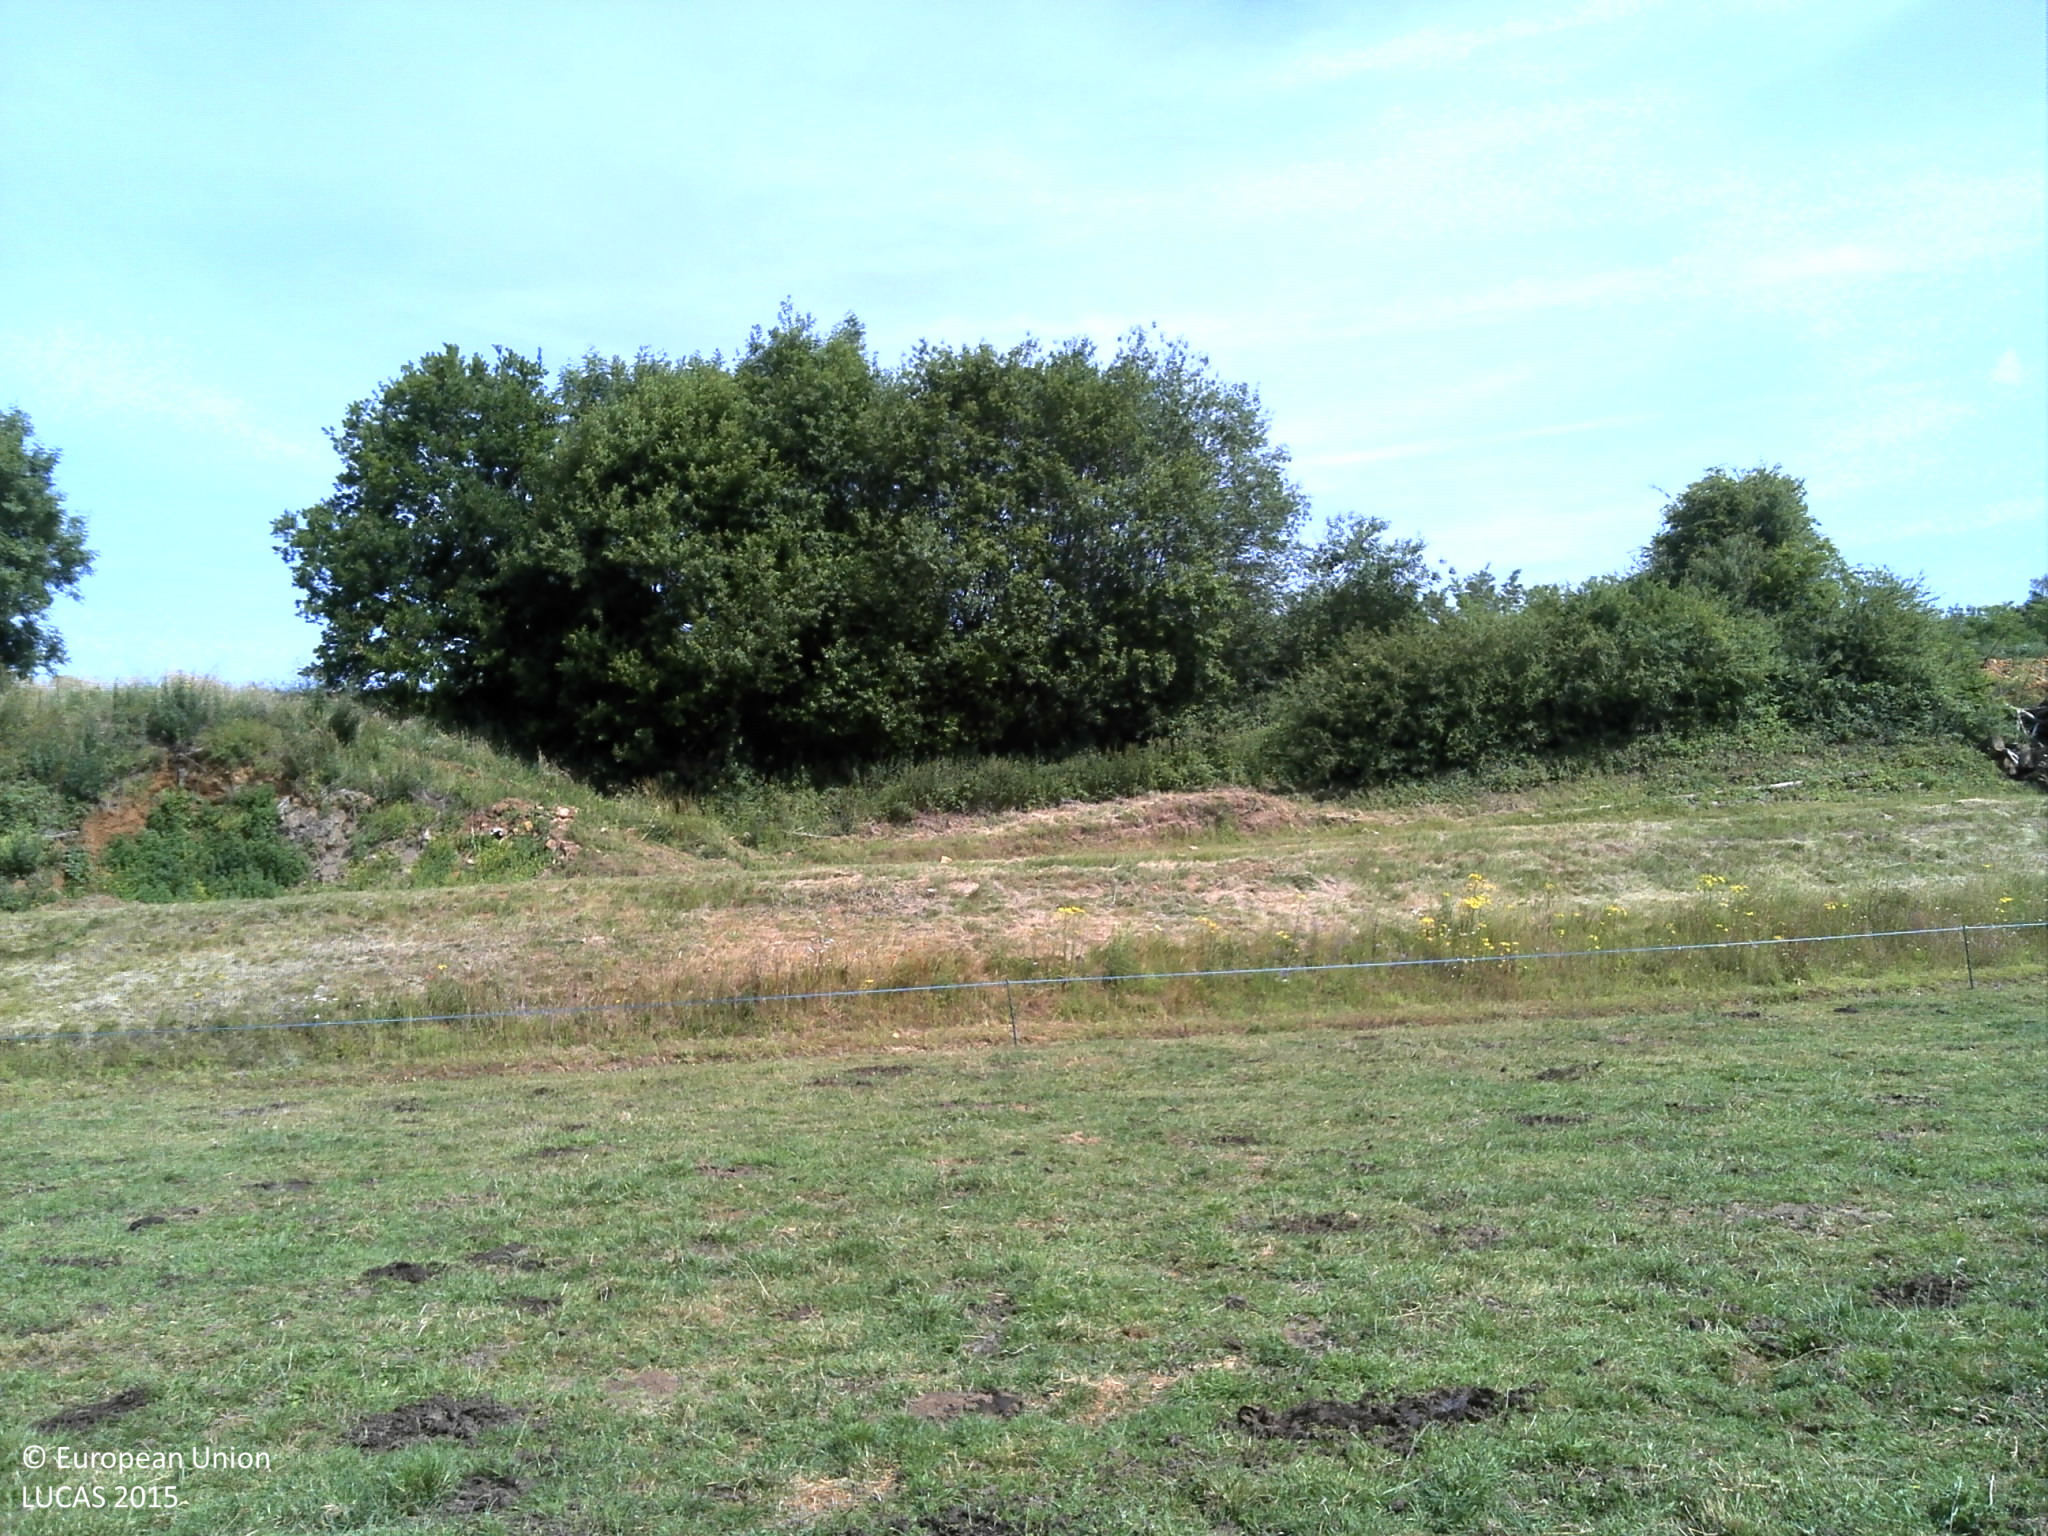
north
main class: Grassland
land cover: Grassland without tree/shrub cover
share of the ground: > 75 %
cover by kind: herbaceous plants 100 %
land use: Agriculture (excluding fallow land and kitchen gardens)
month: June
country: FR
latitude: 49.6959
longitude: 4.9927
